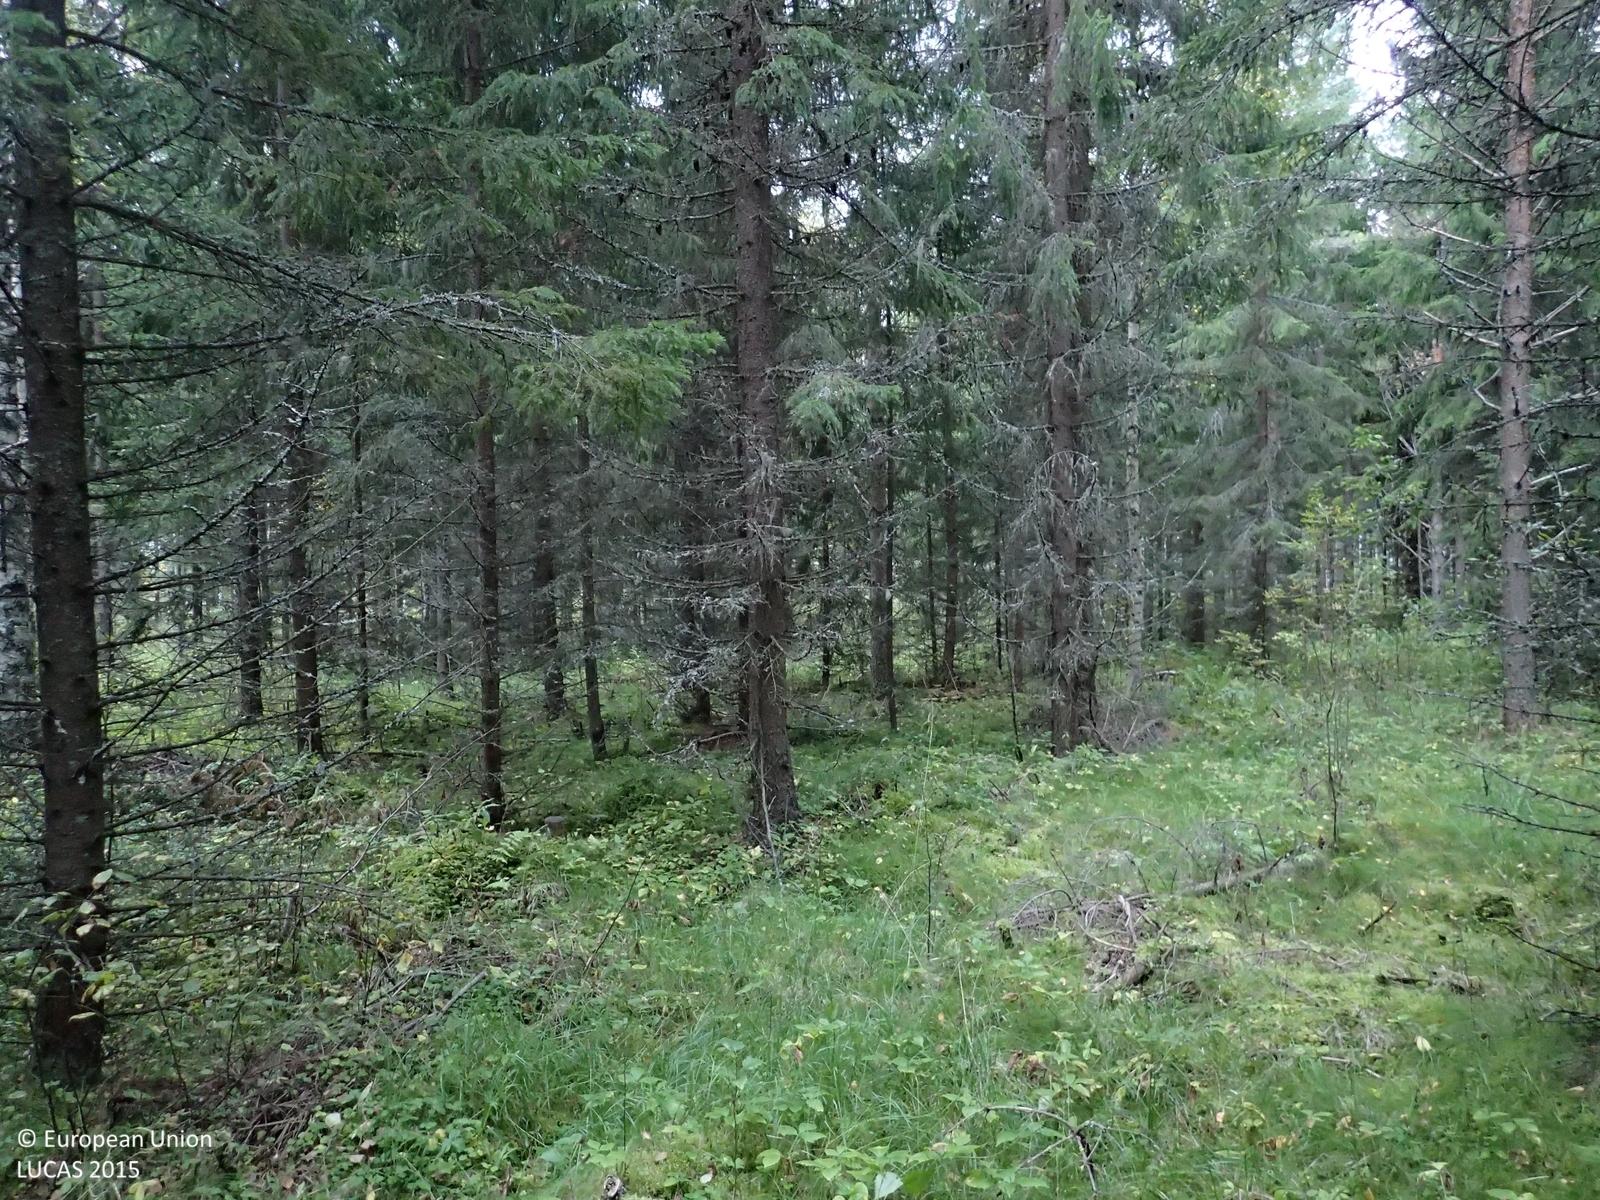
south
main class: Woodland
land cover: Spruce dominated coniferous woodland
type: boreal forest
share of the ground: > 75 %
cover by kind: coniferous forest trees 75 %, lichens and mosses 10 %, broadleaved forest trees 5 %, shrubs 5 %, herbaceous plants 5 %
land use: Forestry
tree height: > 5 m
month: September
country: FI
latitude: 63.0585
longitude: 25.8421
